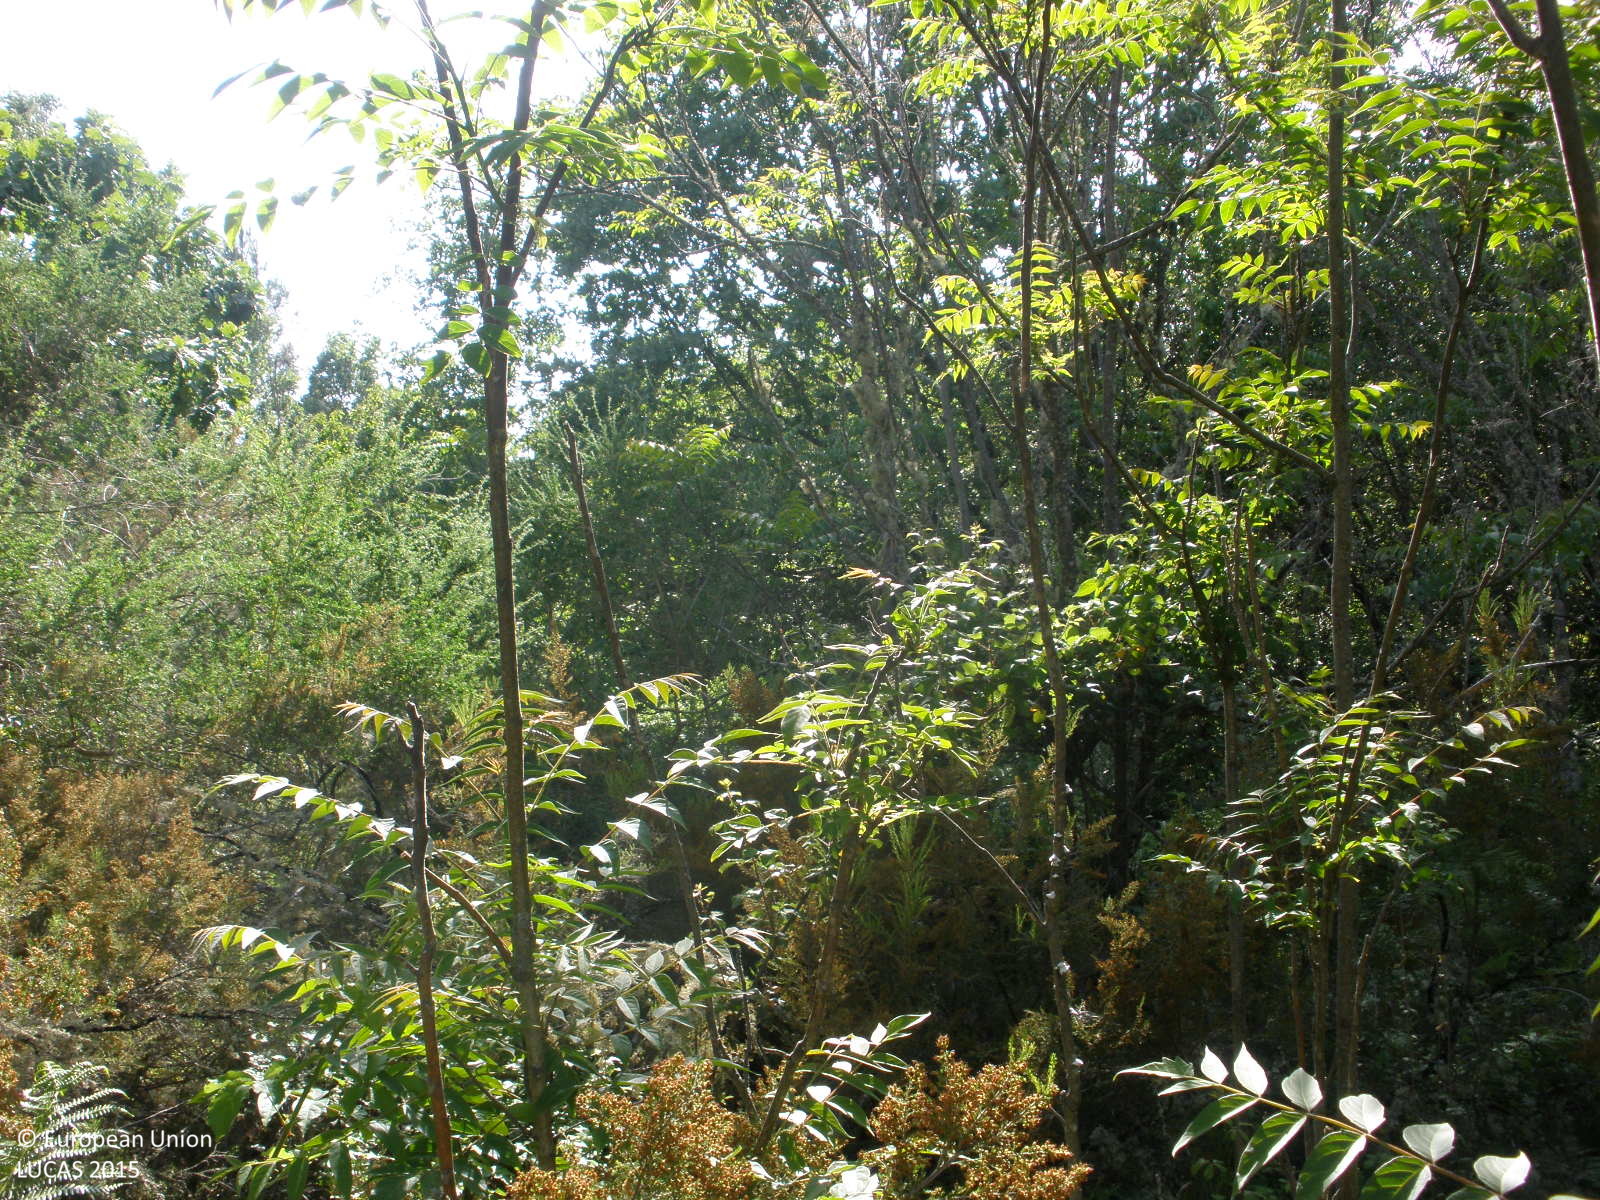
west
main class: Woodland
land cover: Broadleaved woodland
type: thermophilous deciduous forest
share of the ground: > 75 %
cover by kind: broadleaved forest trees 70 %, shrubs 30 %
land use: Semi-natural and natural areas not in use
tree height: > 5 m
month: May
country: ES
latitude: 40.1988
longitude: -6.6378
